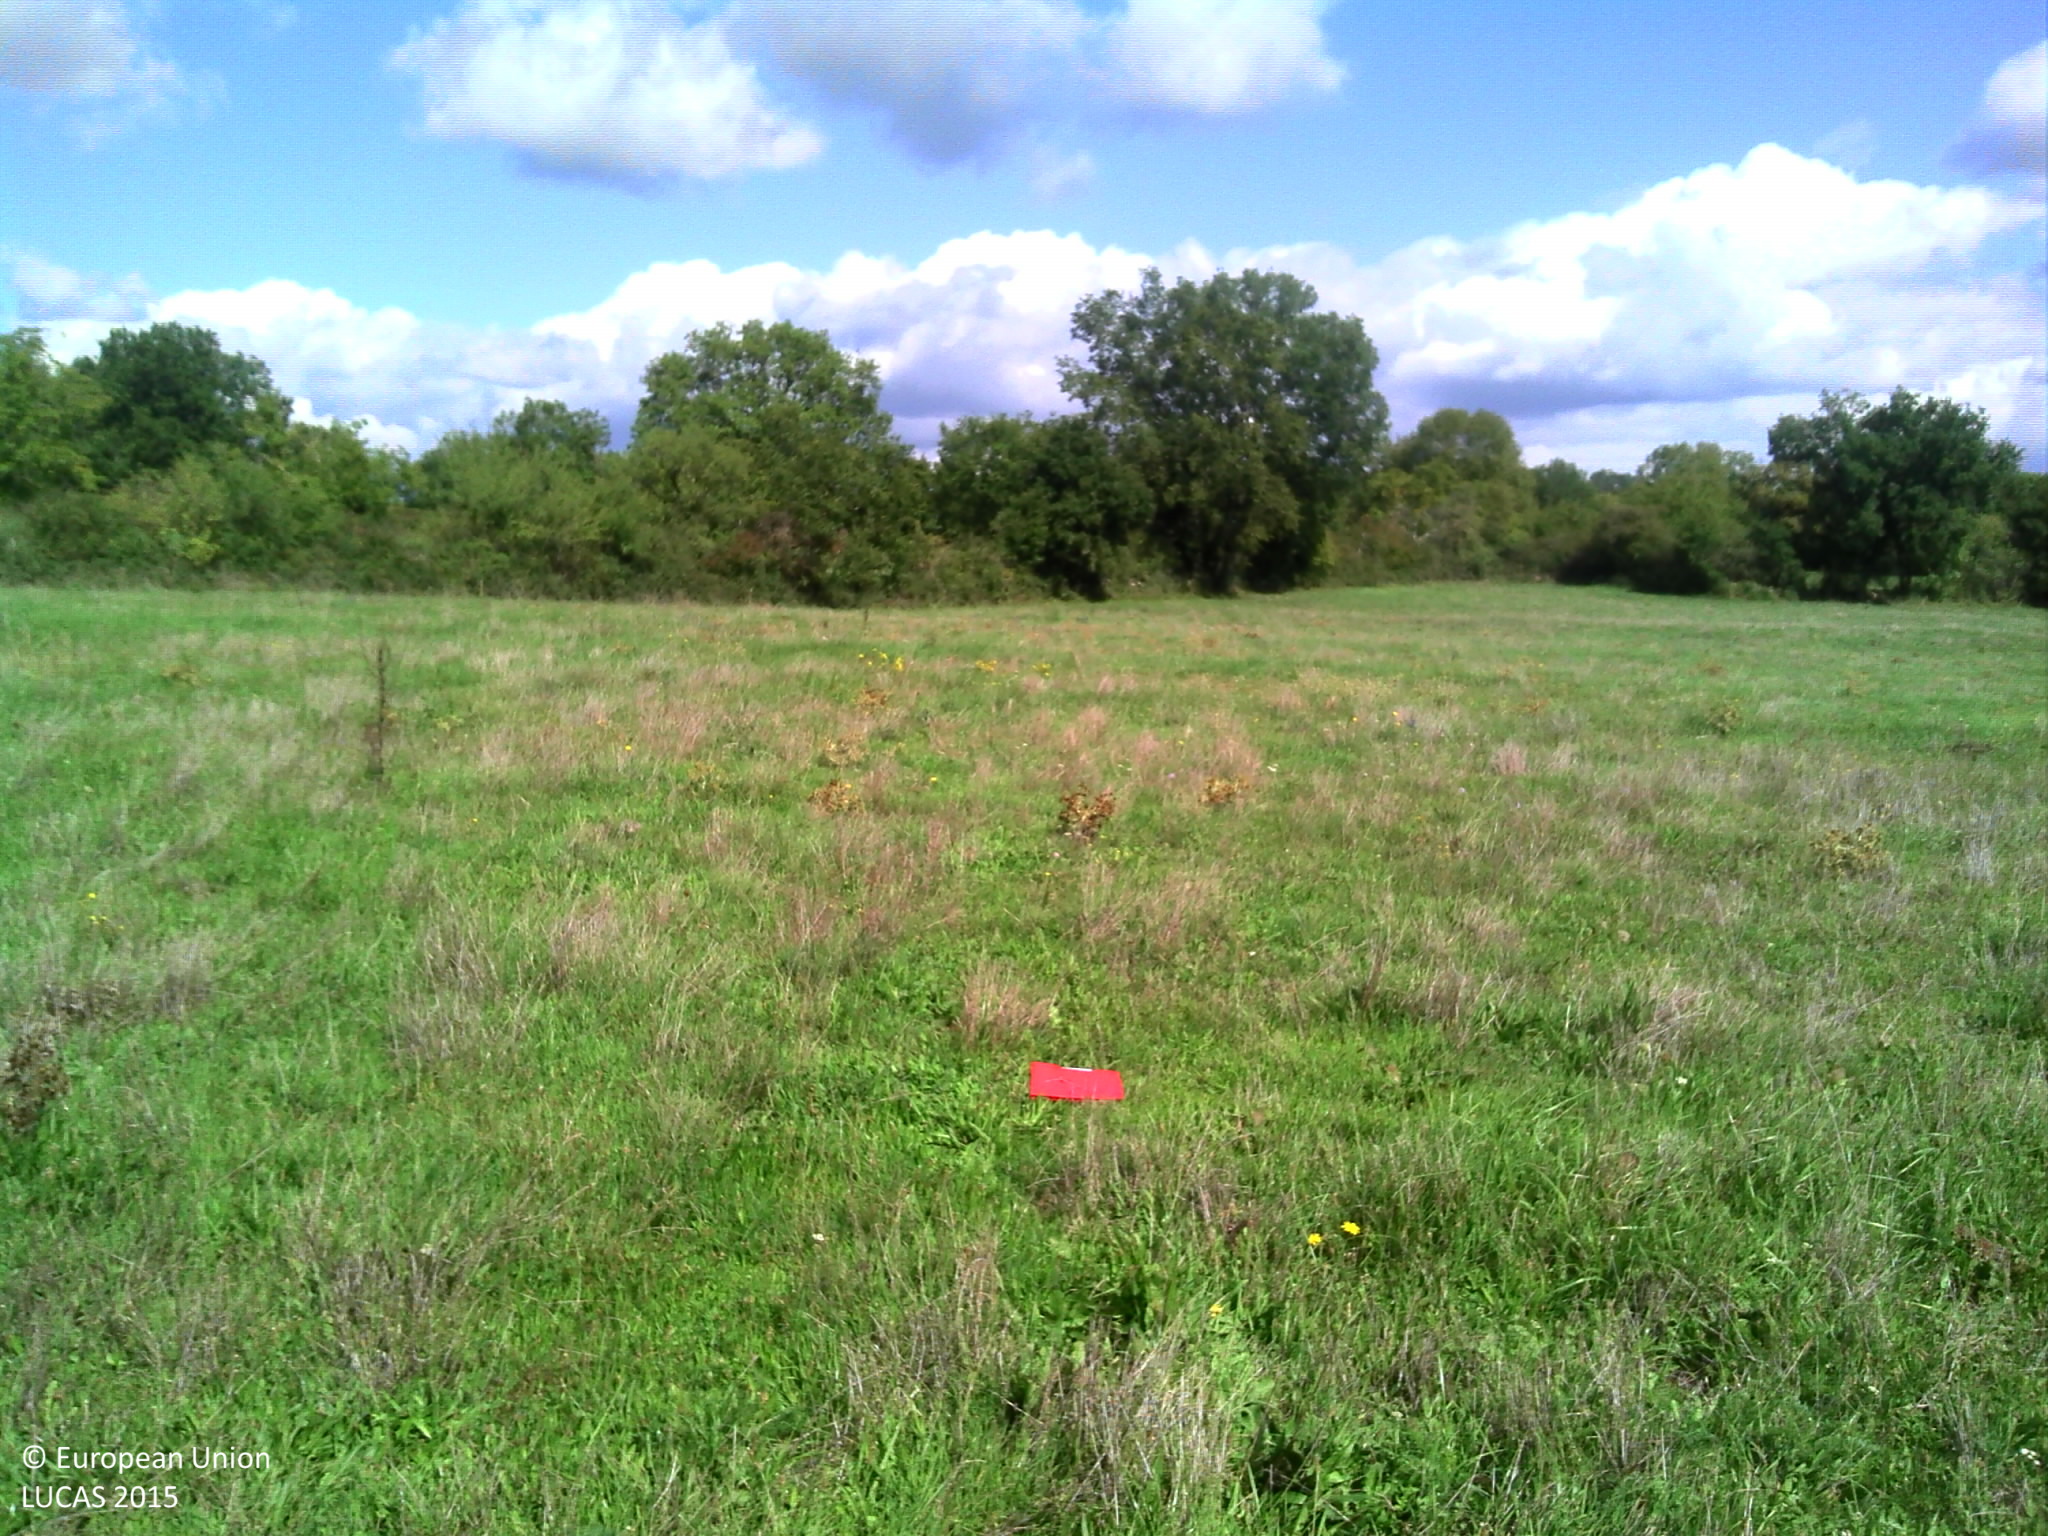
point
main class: Grassland
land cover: Grassland without tree/shrub cover
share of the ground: > 75 %
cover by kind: herbaceous plants 100 %
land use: Agriculture (excluding fallow land and kitchen gardens)
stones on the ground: < 10 %
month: September
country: FR
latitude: 44.7664
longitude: 1.7732
